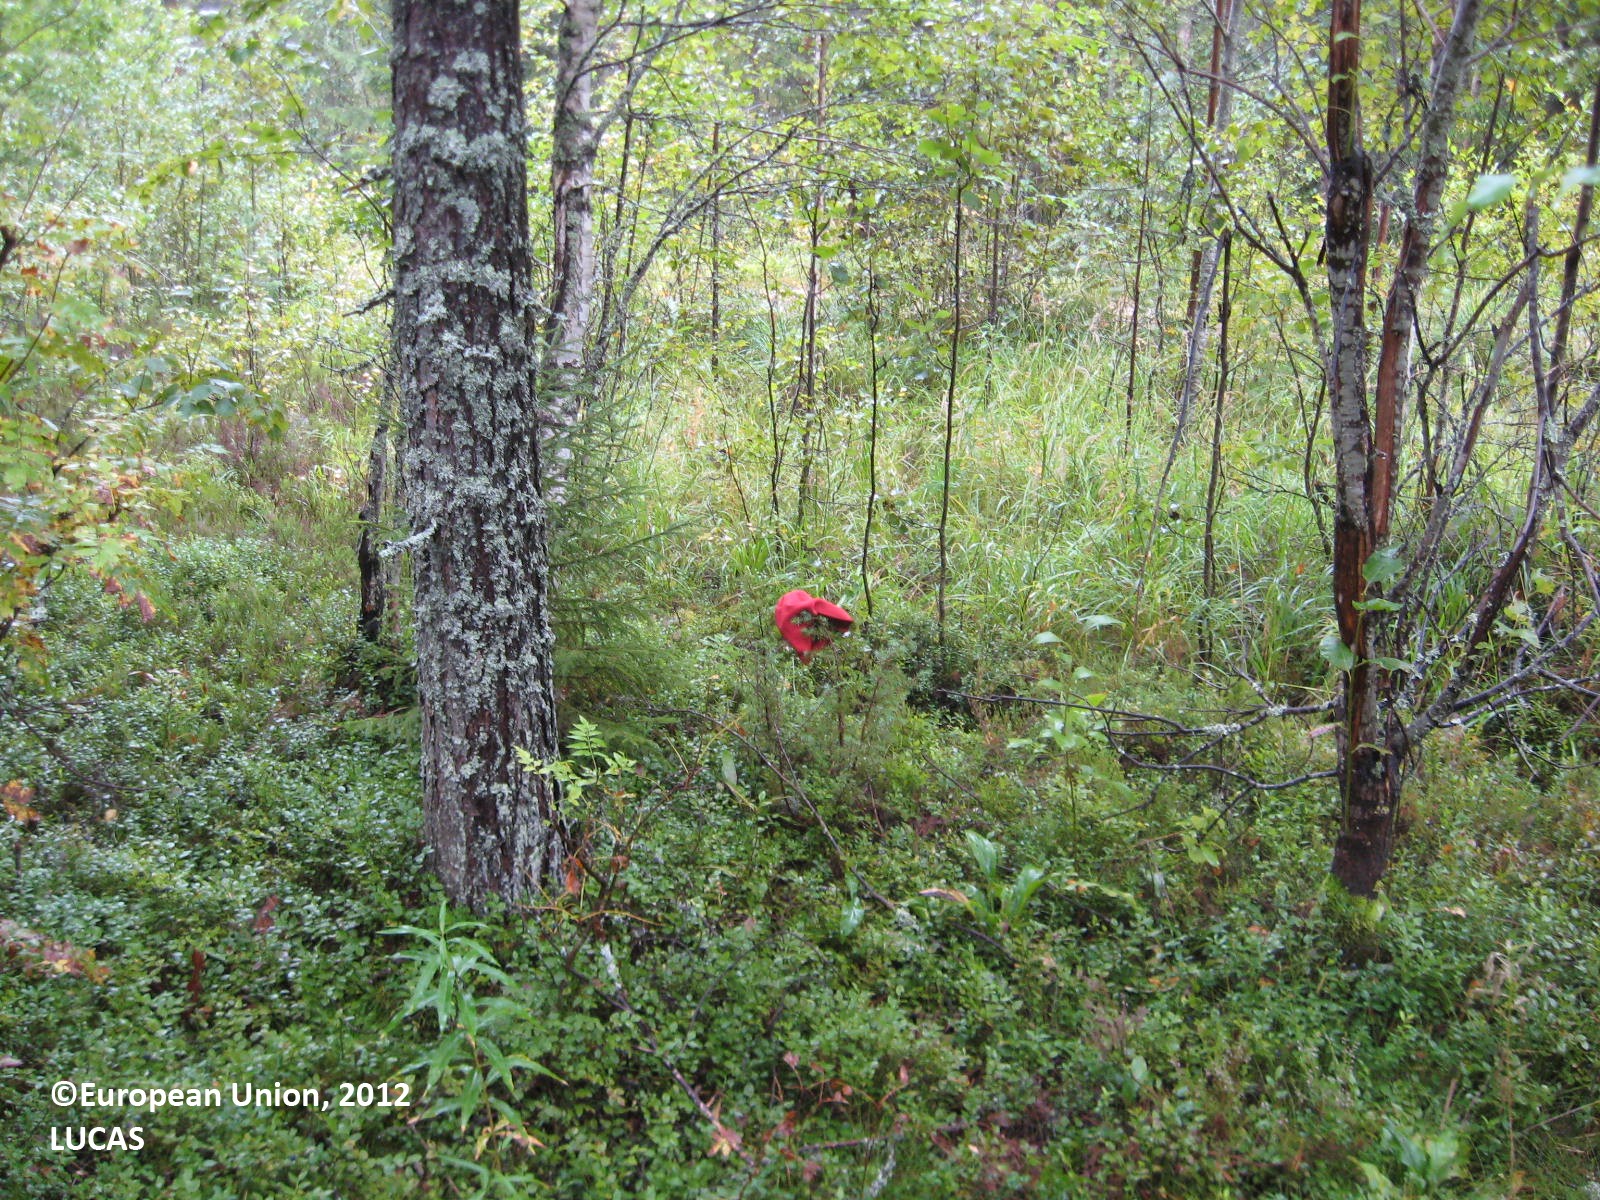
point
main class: Woodland
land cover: Pine dominated coniferous woodland
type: boreal forest
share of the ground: > 75 %
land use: Forestry
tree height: > 5 m
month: August
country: FI
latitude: 63.5671
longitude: 29.4534
